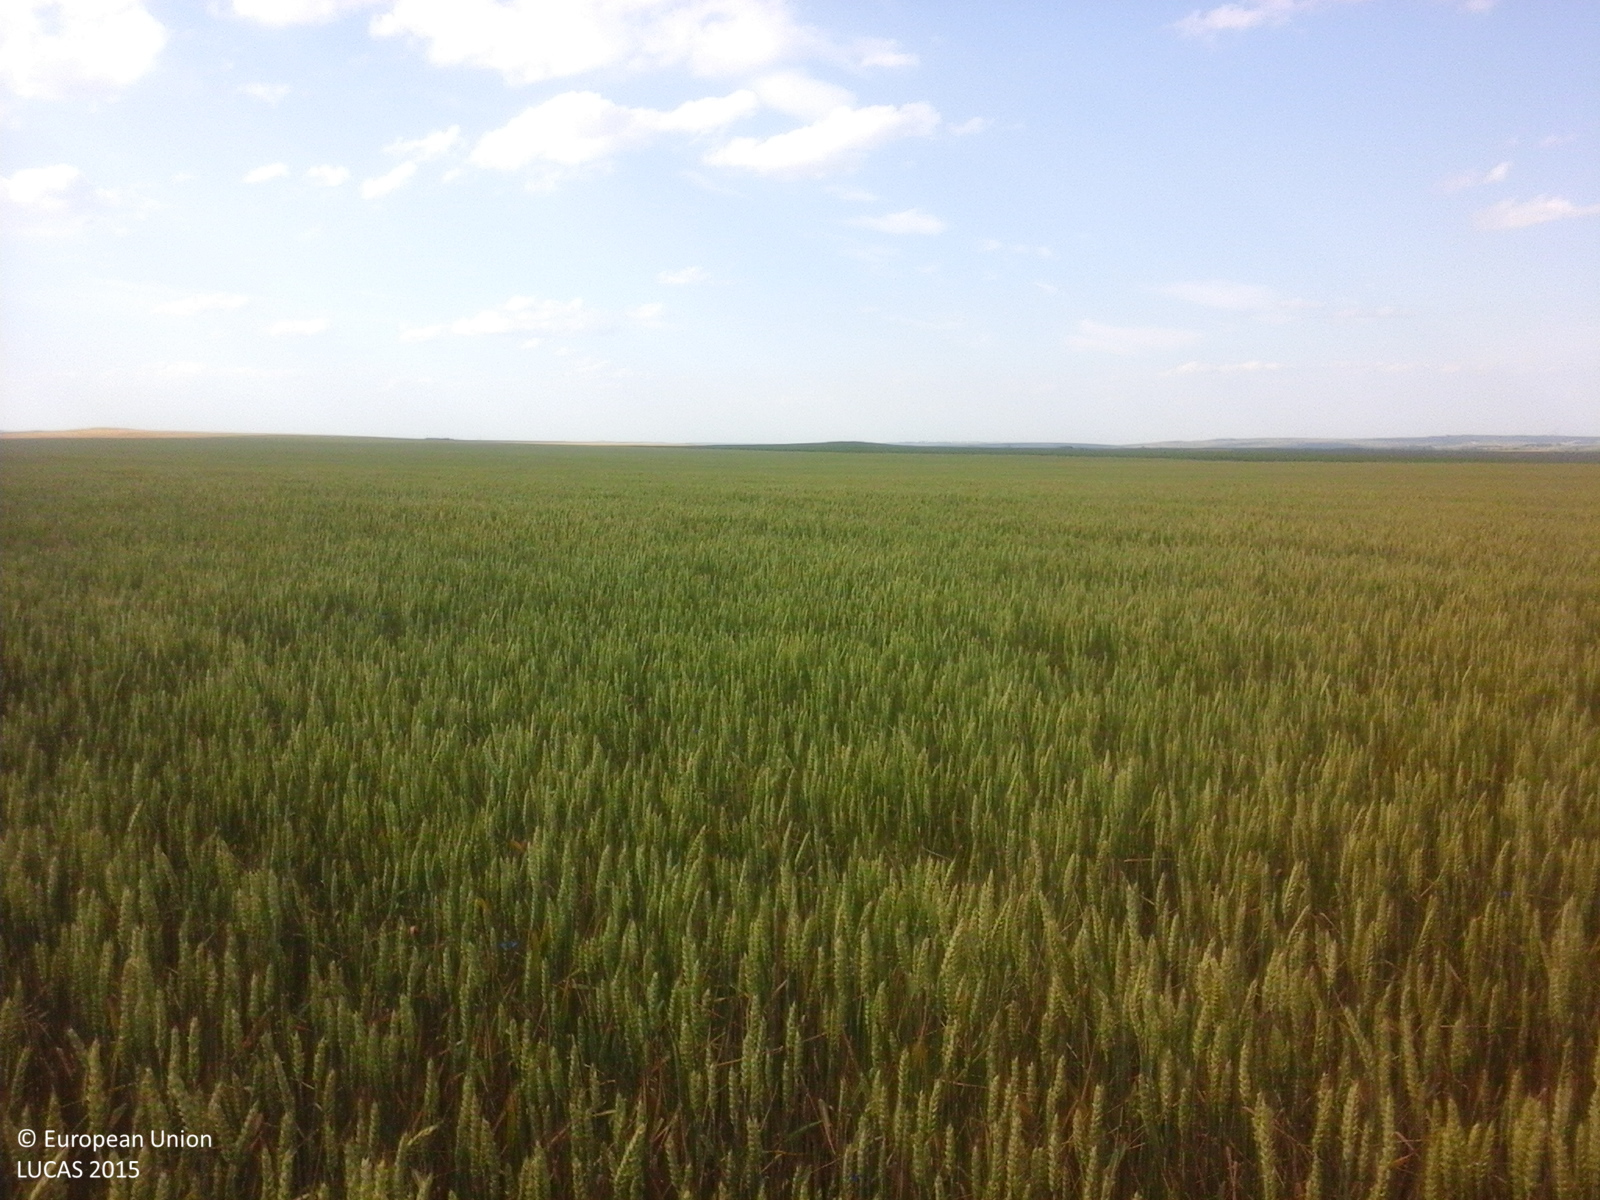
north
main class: Cropland
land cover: Common wheat
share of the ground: > 75 %
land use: Agriculture (excluding fallow land and kitchen gardens)
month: June
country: RO
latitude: 47.8869
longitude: 26.5006
